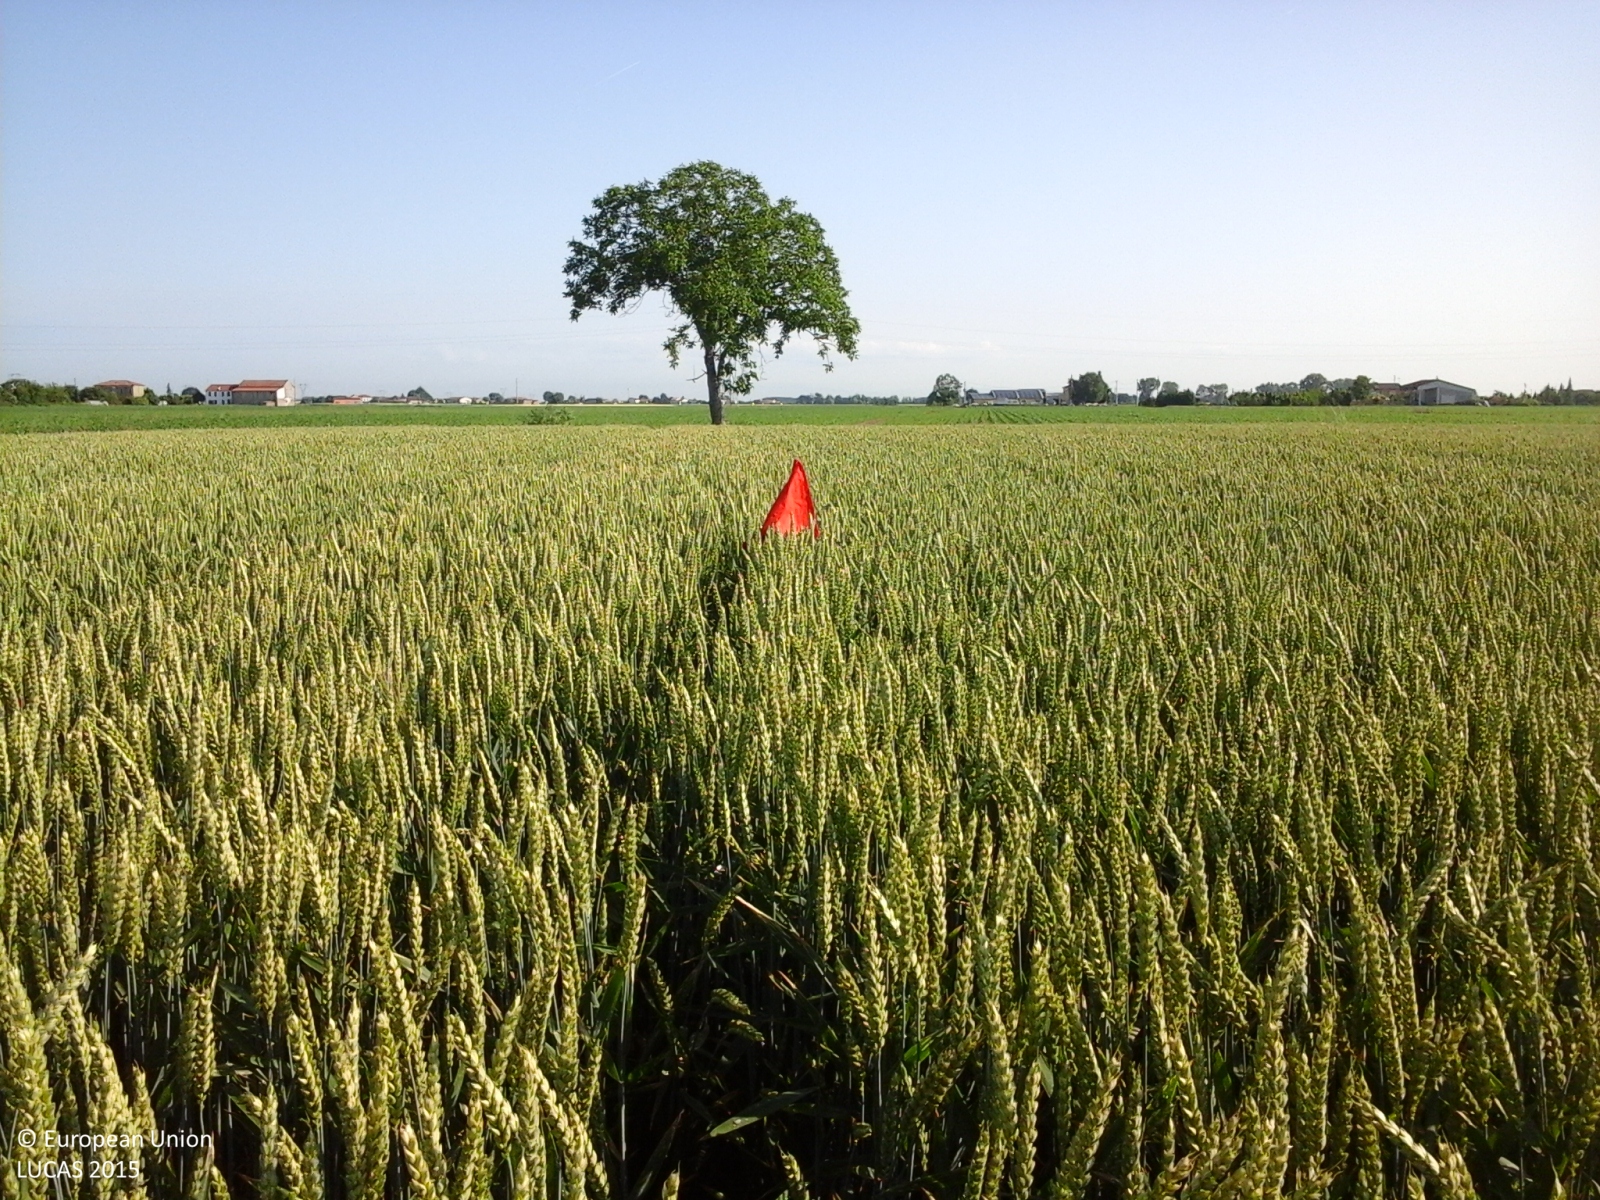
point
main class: Cropland
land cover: Common wheat
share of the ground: > 75 %
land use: Agriculture (excluding fallow land and kitchen gardens)
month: May
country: IT
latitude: 45.0652
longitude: 11.1789
